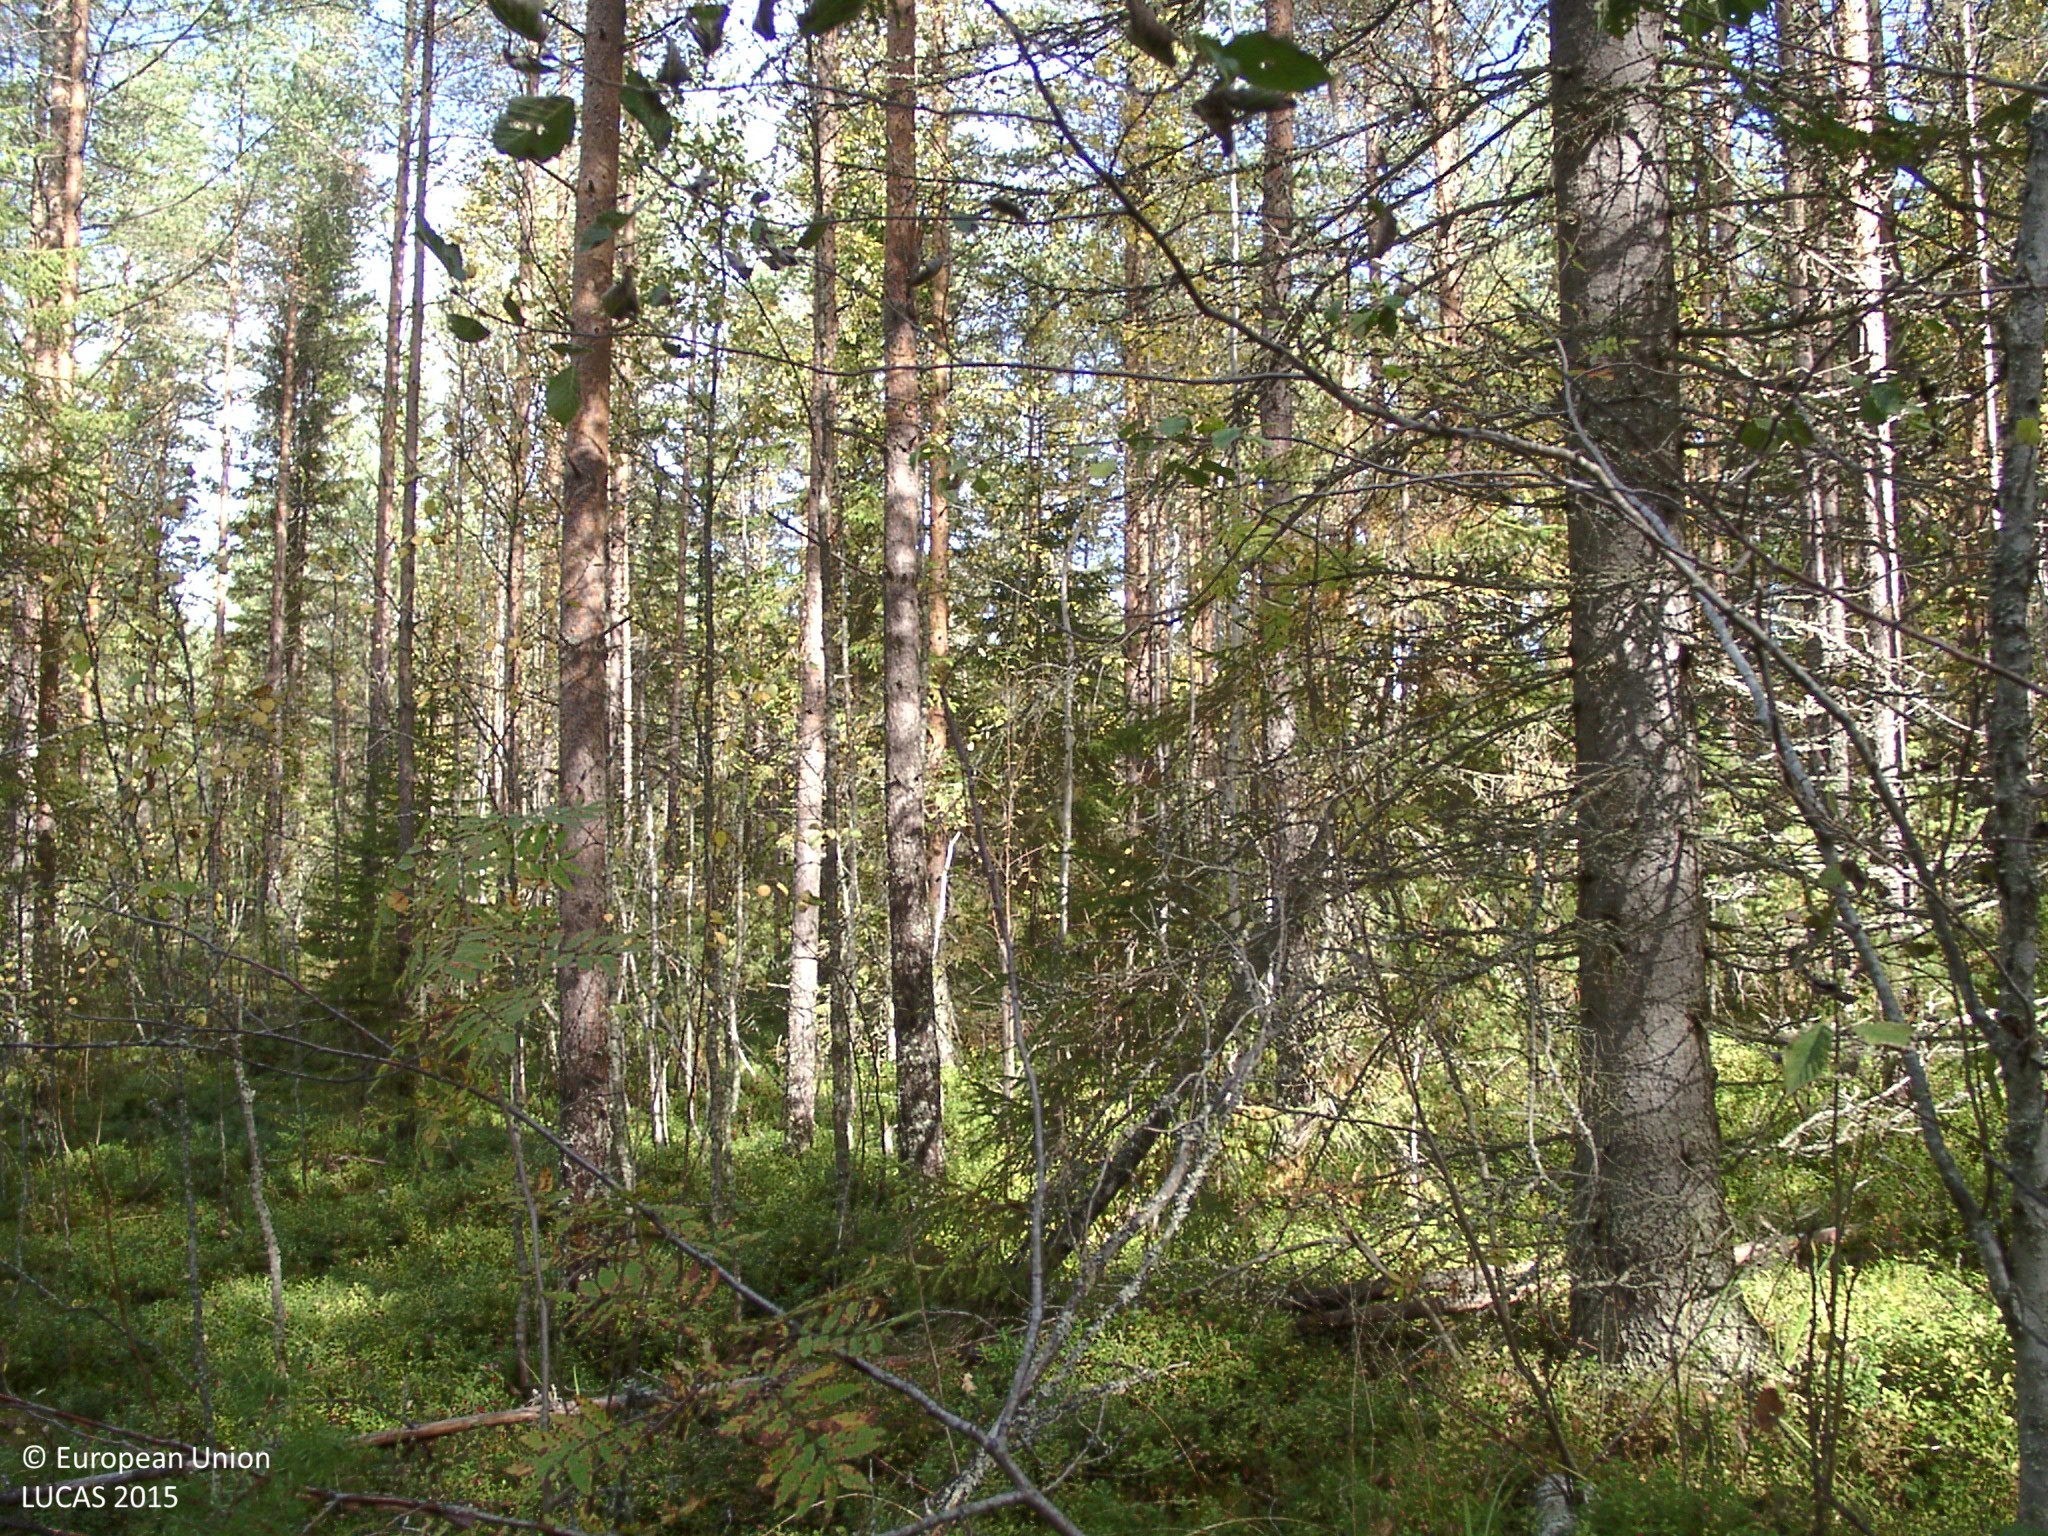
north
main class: Woodland
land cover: Pine dominated coniferous woodland
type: boreal forest
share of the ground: 50 - 75 %
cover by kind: coniferous forest trees 55 %, shrubs 25 %, broadleaved forest trees 10 %, herbaceous plants 5 %, lichens and mosses 5 %
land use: Forestry
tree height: > 5 m
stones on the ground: < 10 %
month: September
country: FI
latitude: 62.5260
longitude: 25.2808
